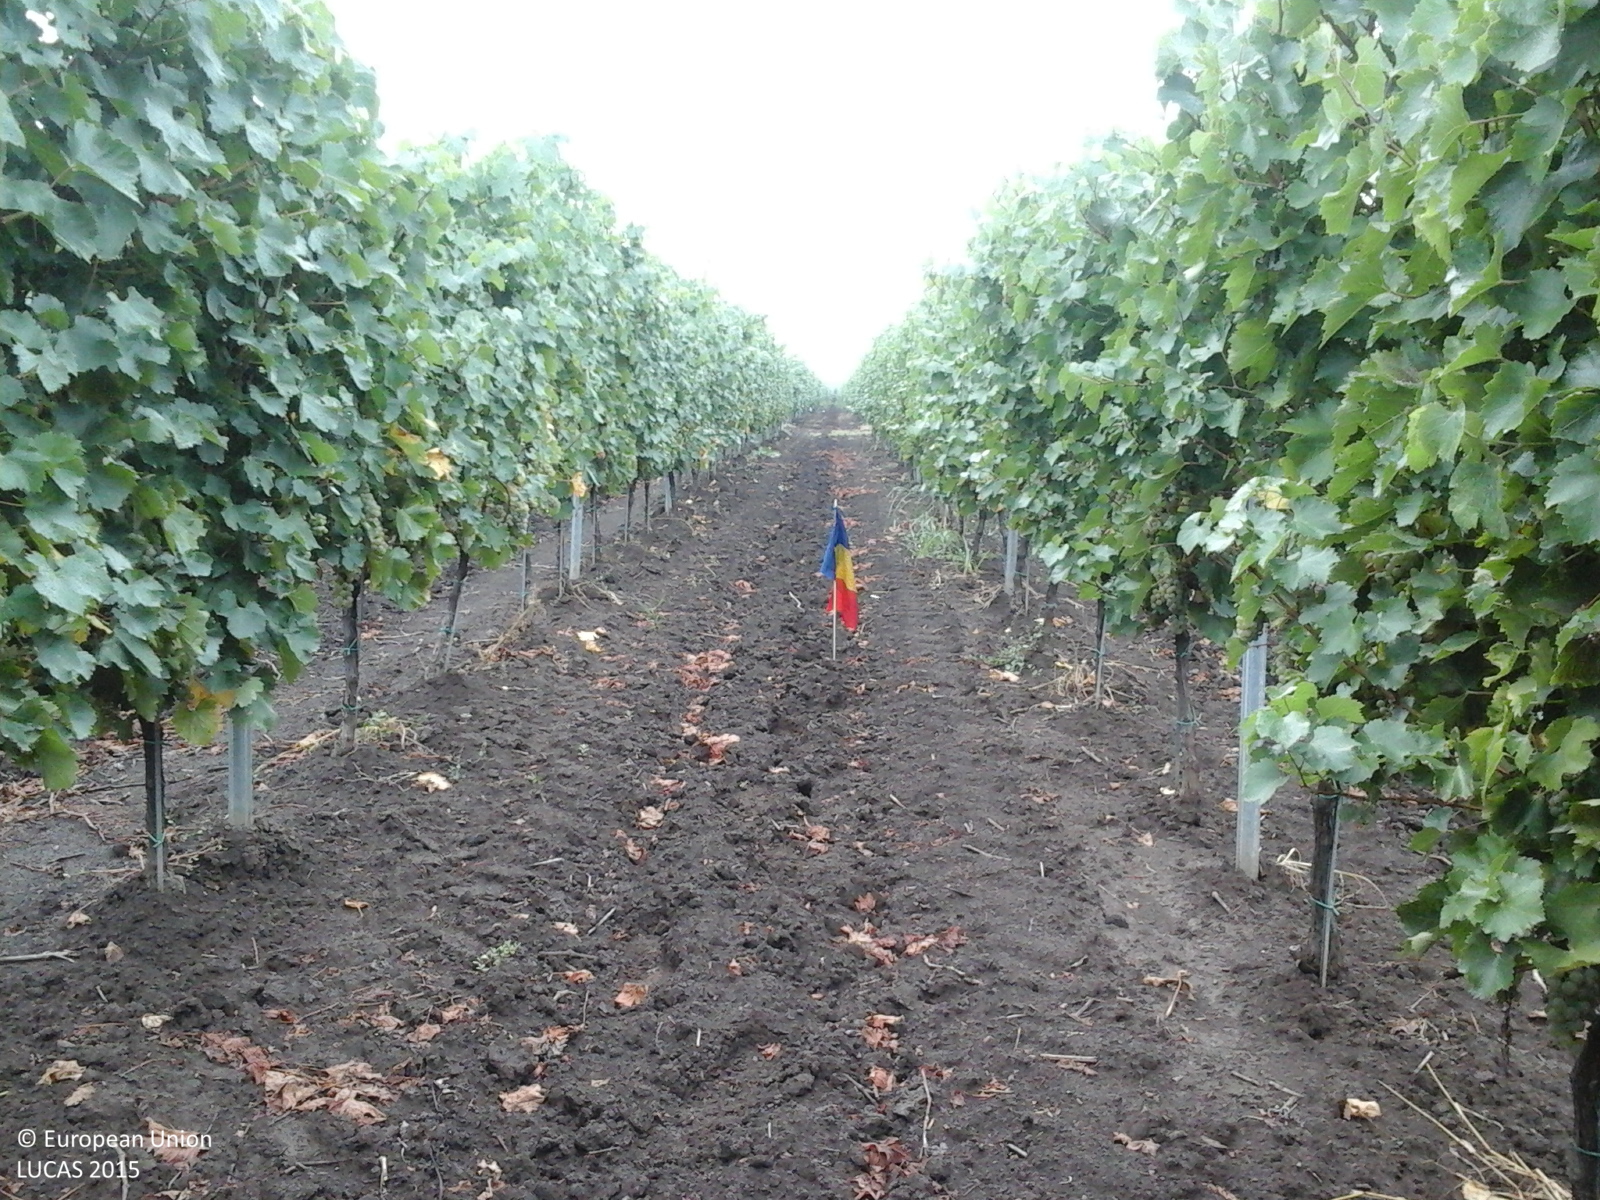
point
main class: Cropland
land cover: Vineyards
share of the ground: 50 - 75 %
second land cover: Other bare soil
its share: > 75 %
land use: Agriculture (excluding fallow land and kitchen gardens)
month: August
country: RO
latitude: 45.8372
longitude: 21.5057
